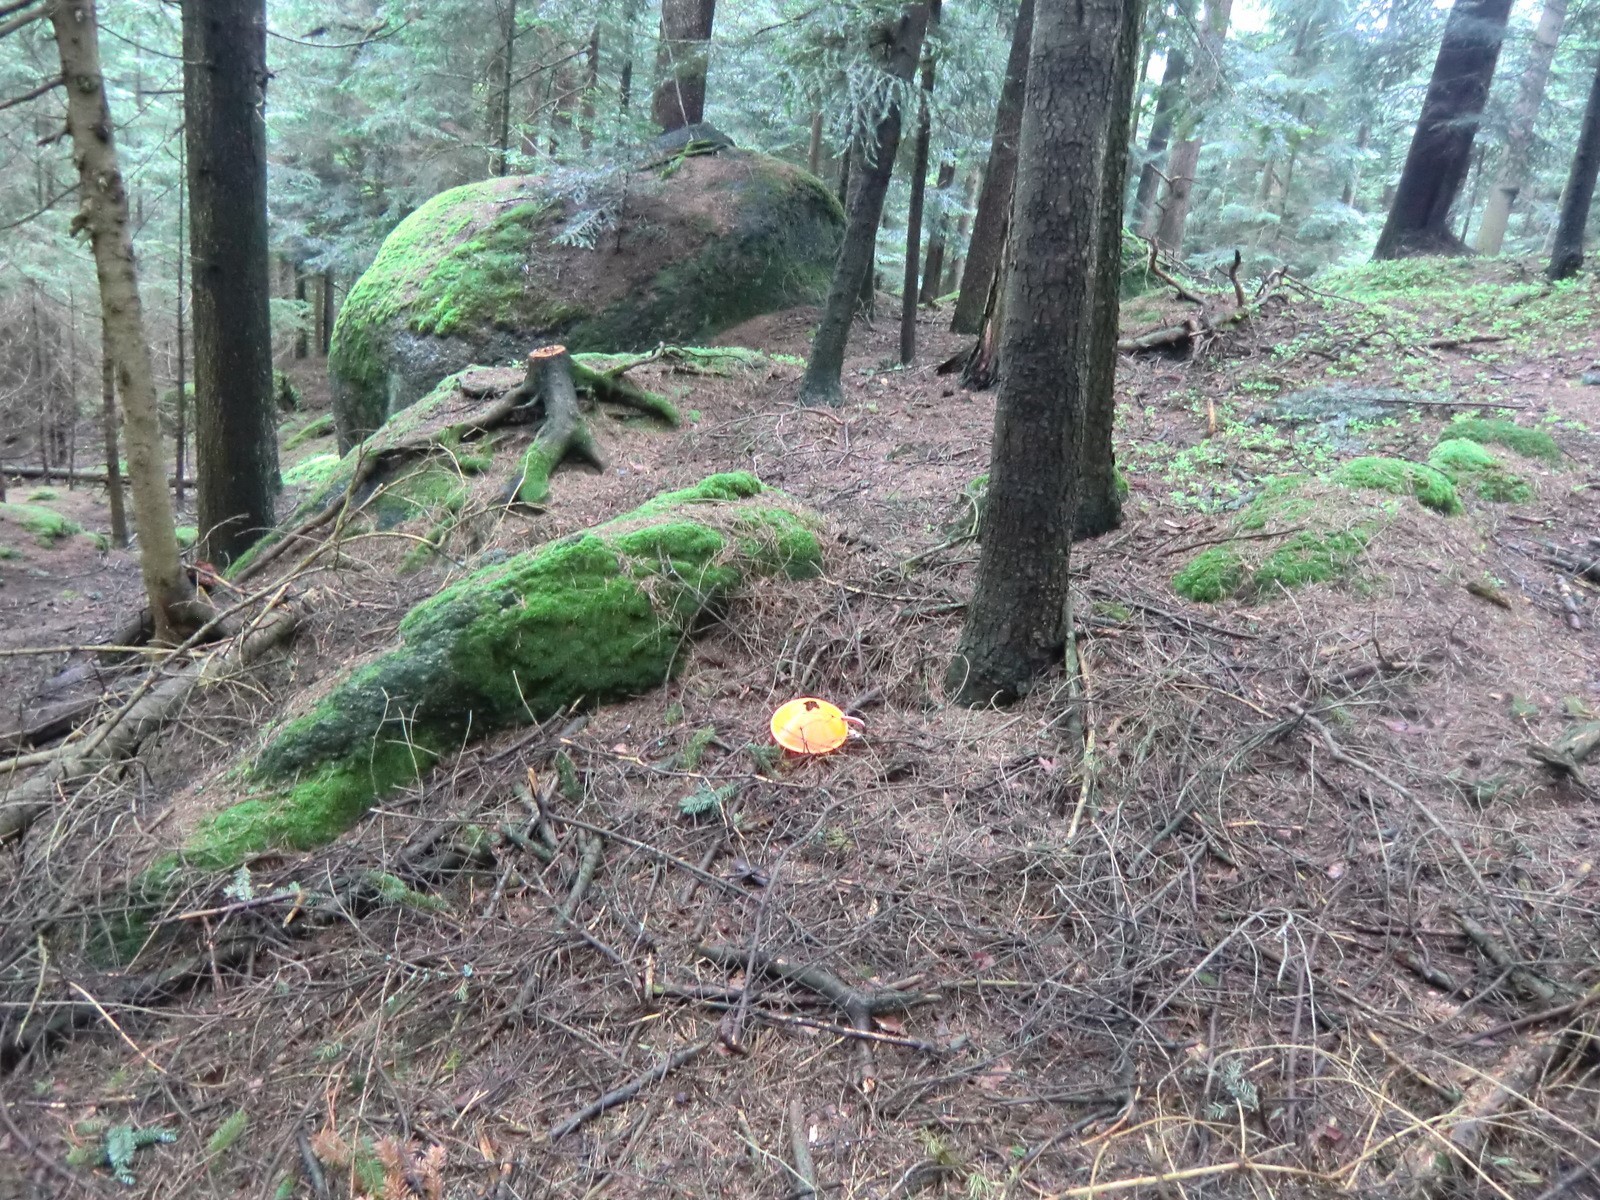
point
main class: Woodland
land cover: Spruce dominated coniferous woodland
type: hemiboreal forest and nemoral coniferous forest and mixed broadleaved-coniferous forest
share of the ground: > 75 %
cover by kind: coniferous forest trees 80 %, unconsolidated bare surface 10 %, lichens and mosses 5 %
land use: Forestry
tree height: > 5 m
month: May
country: AT
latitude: 48.3190
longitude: 14.7614
